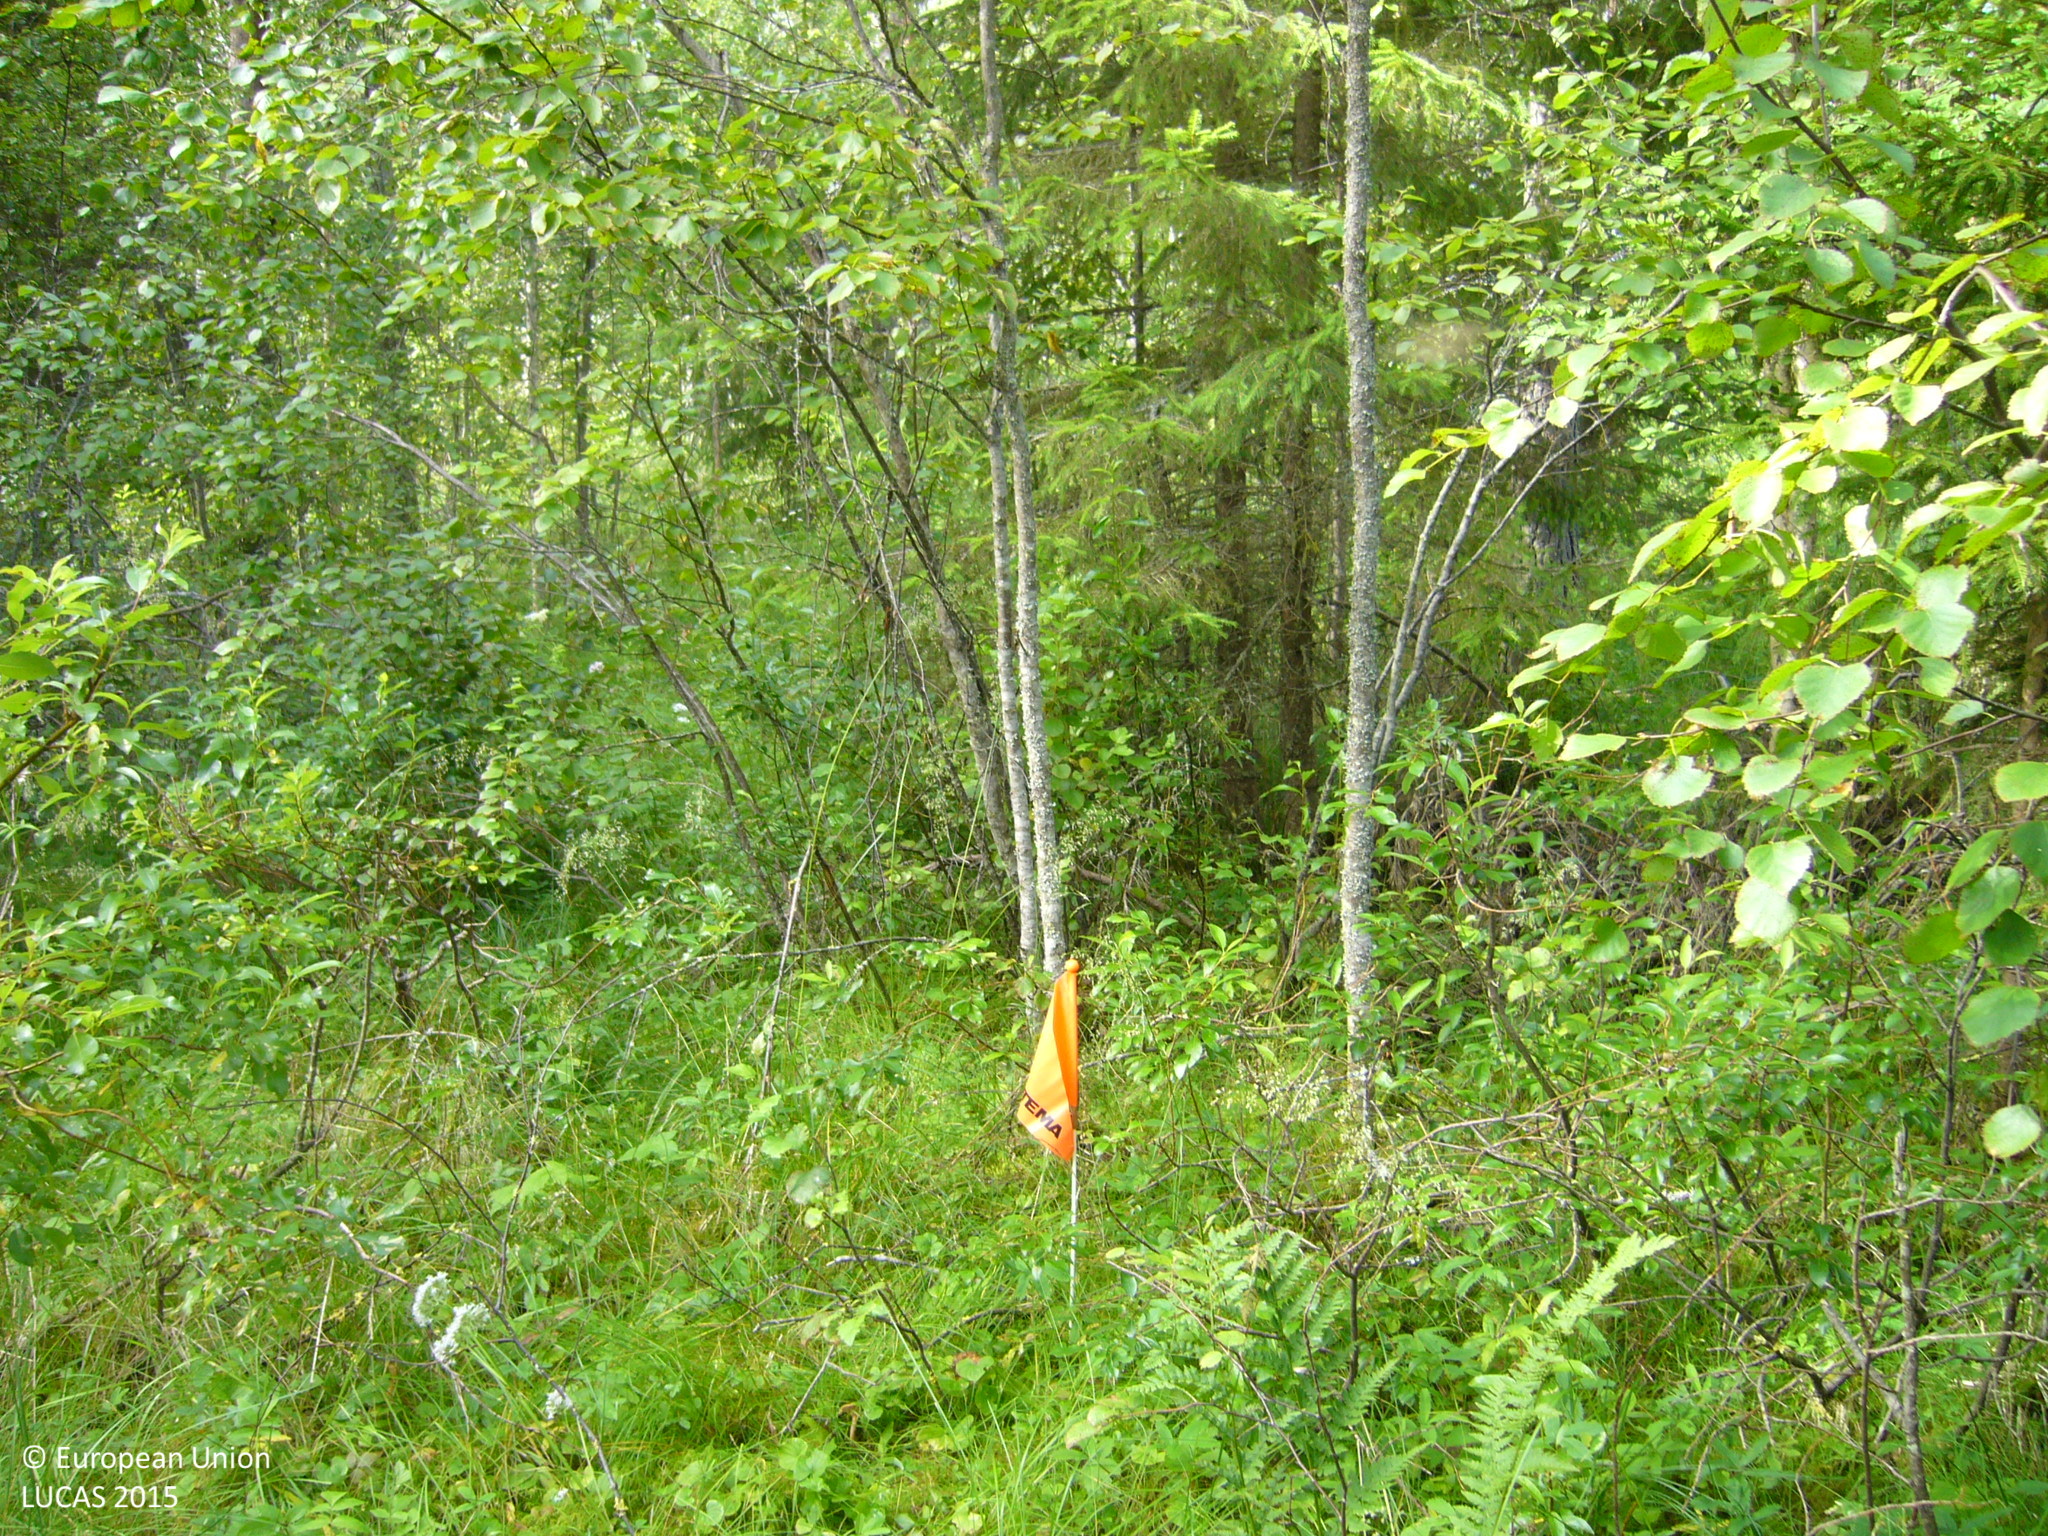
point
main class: Woodland
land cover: Pine dominated mixed woodland
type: boreal forest
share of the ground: 50 - 75 %
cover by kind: broadleaved forest trees 40 %, coniferous forest trees 30 %, herbaceous plants 20 %, shrubs 10 %
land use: Forestry
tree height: > 5 m
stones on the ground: < 10 %
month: July
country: FI
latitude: 63.9355
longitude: 26.1248
